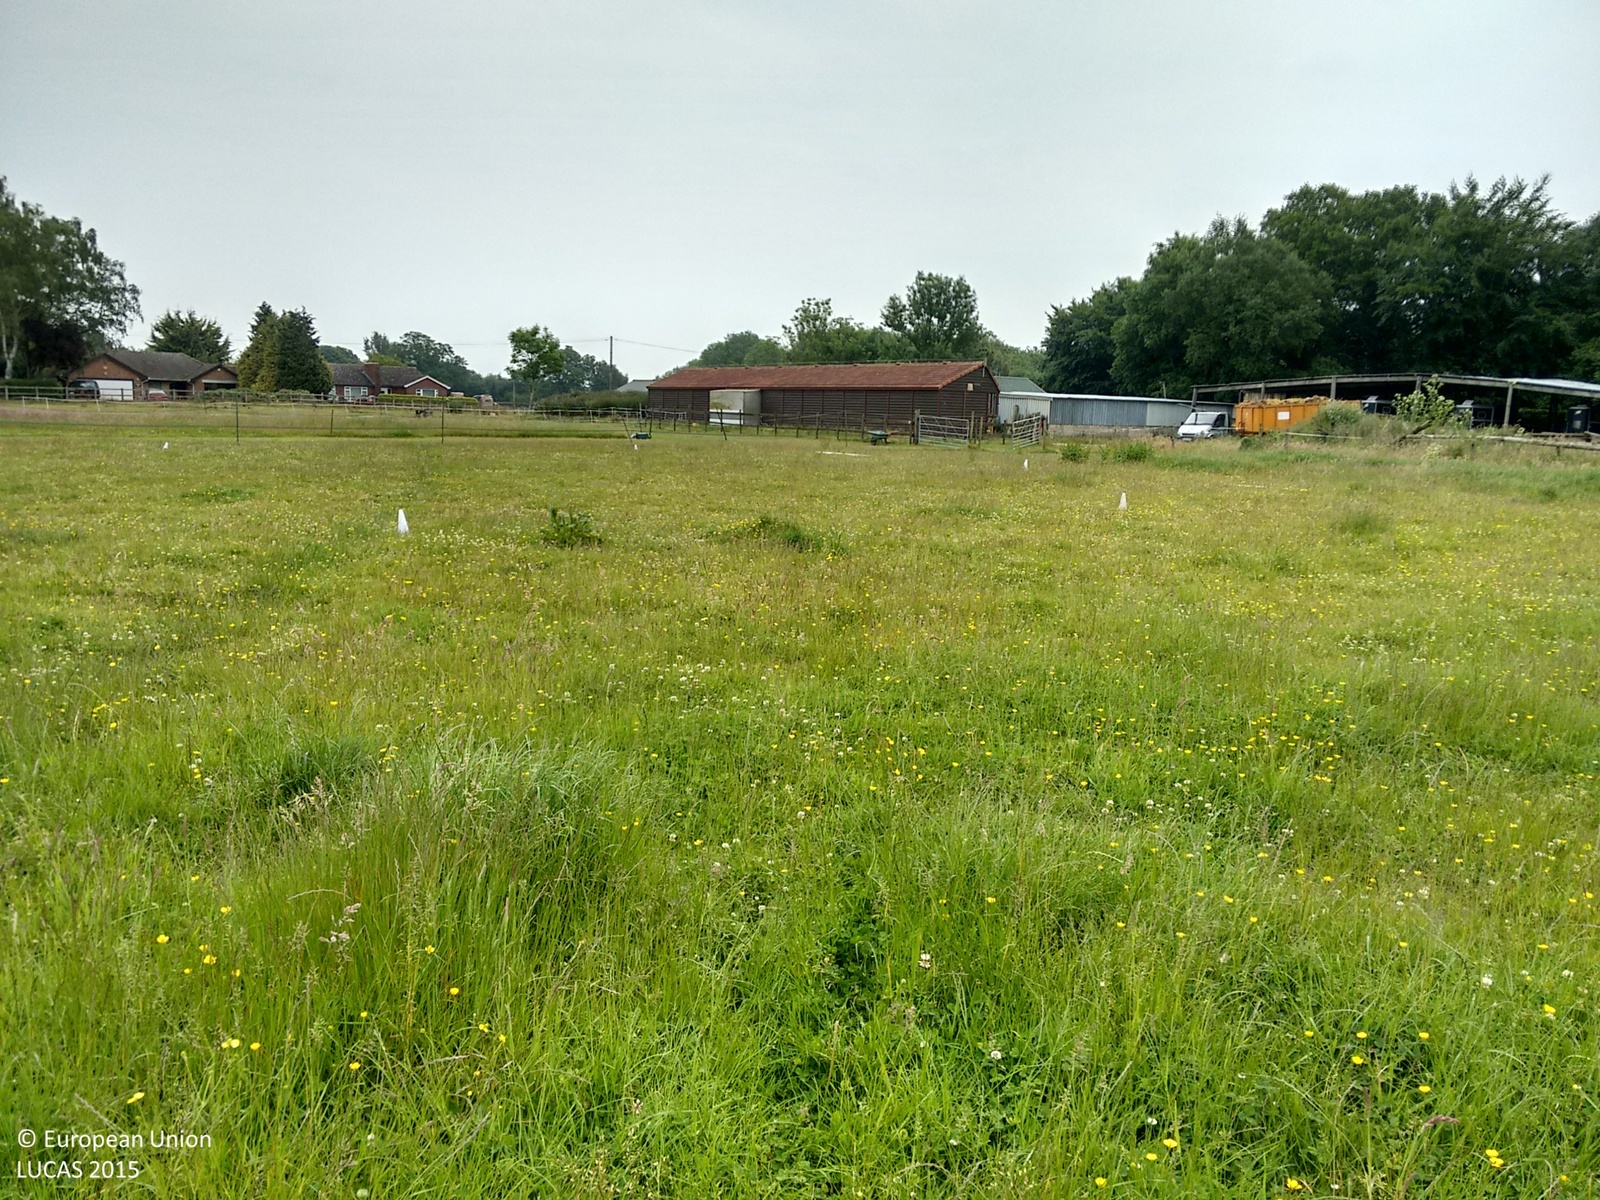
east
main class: Grassland
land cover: Grassland without tree/shrub cover
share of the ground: > 75 %
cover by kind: herbaceous plants 100 %
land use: Agriculture (excluding fallow land and kitchen gardens)
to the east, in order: Grassland without tree/shrub cover; Fences; Grassland without tree/shrub cover; Fences; Grass margins; Fences; Grassland without tree/shrub cover; Artificial constructions in urban areas; Managed hedges; Grassland without tree/shrub cover
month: June
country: GB
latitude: 51.4136
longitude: -1.1610
